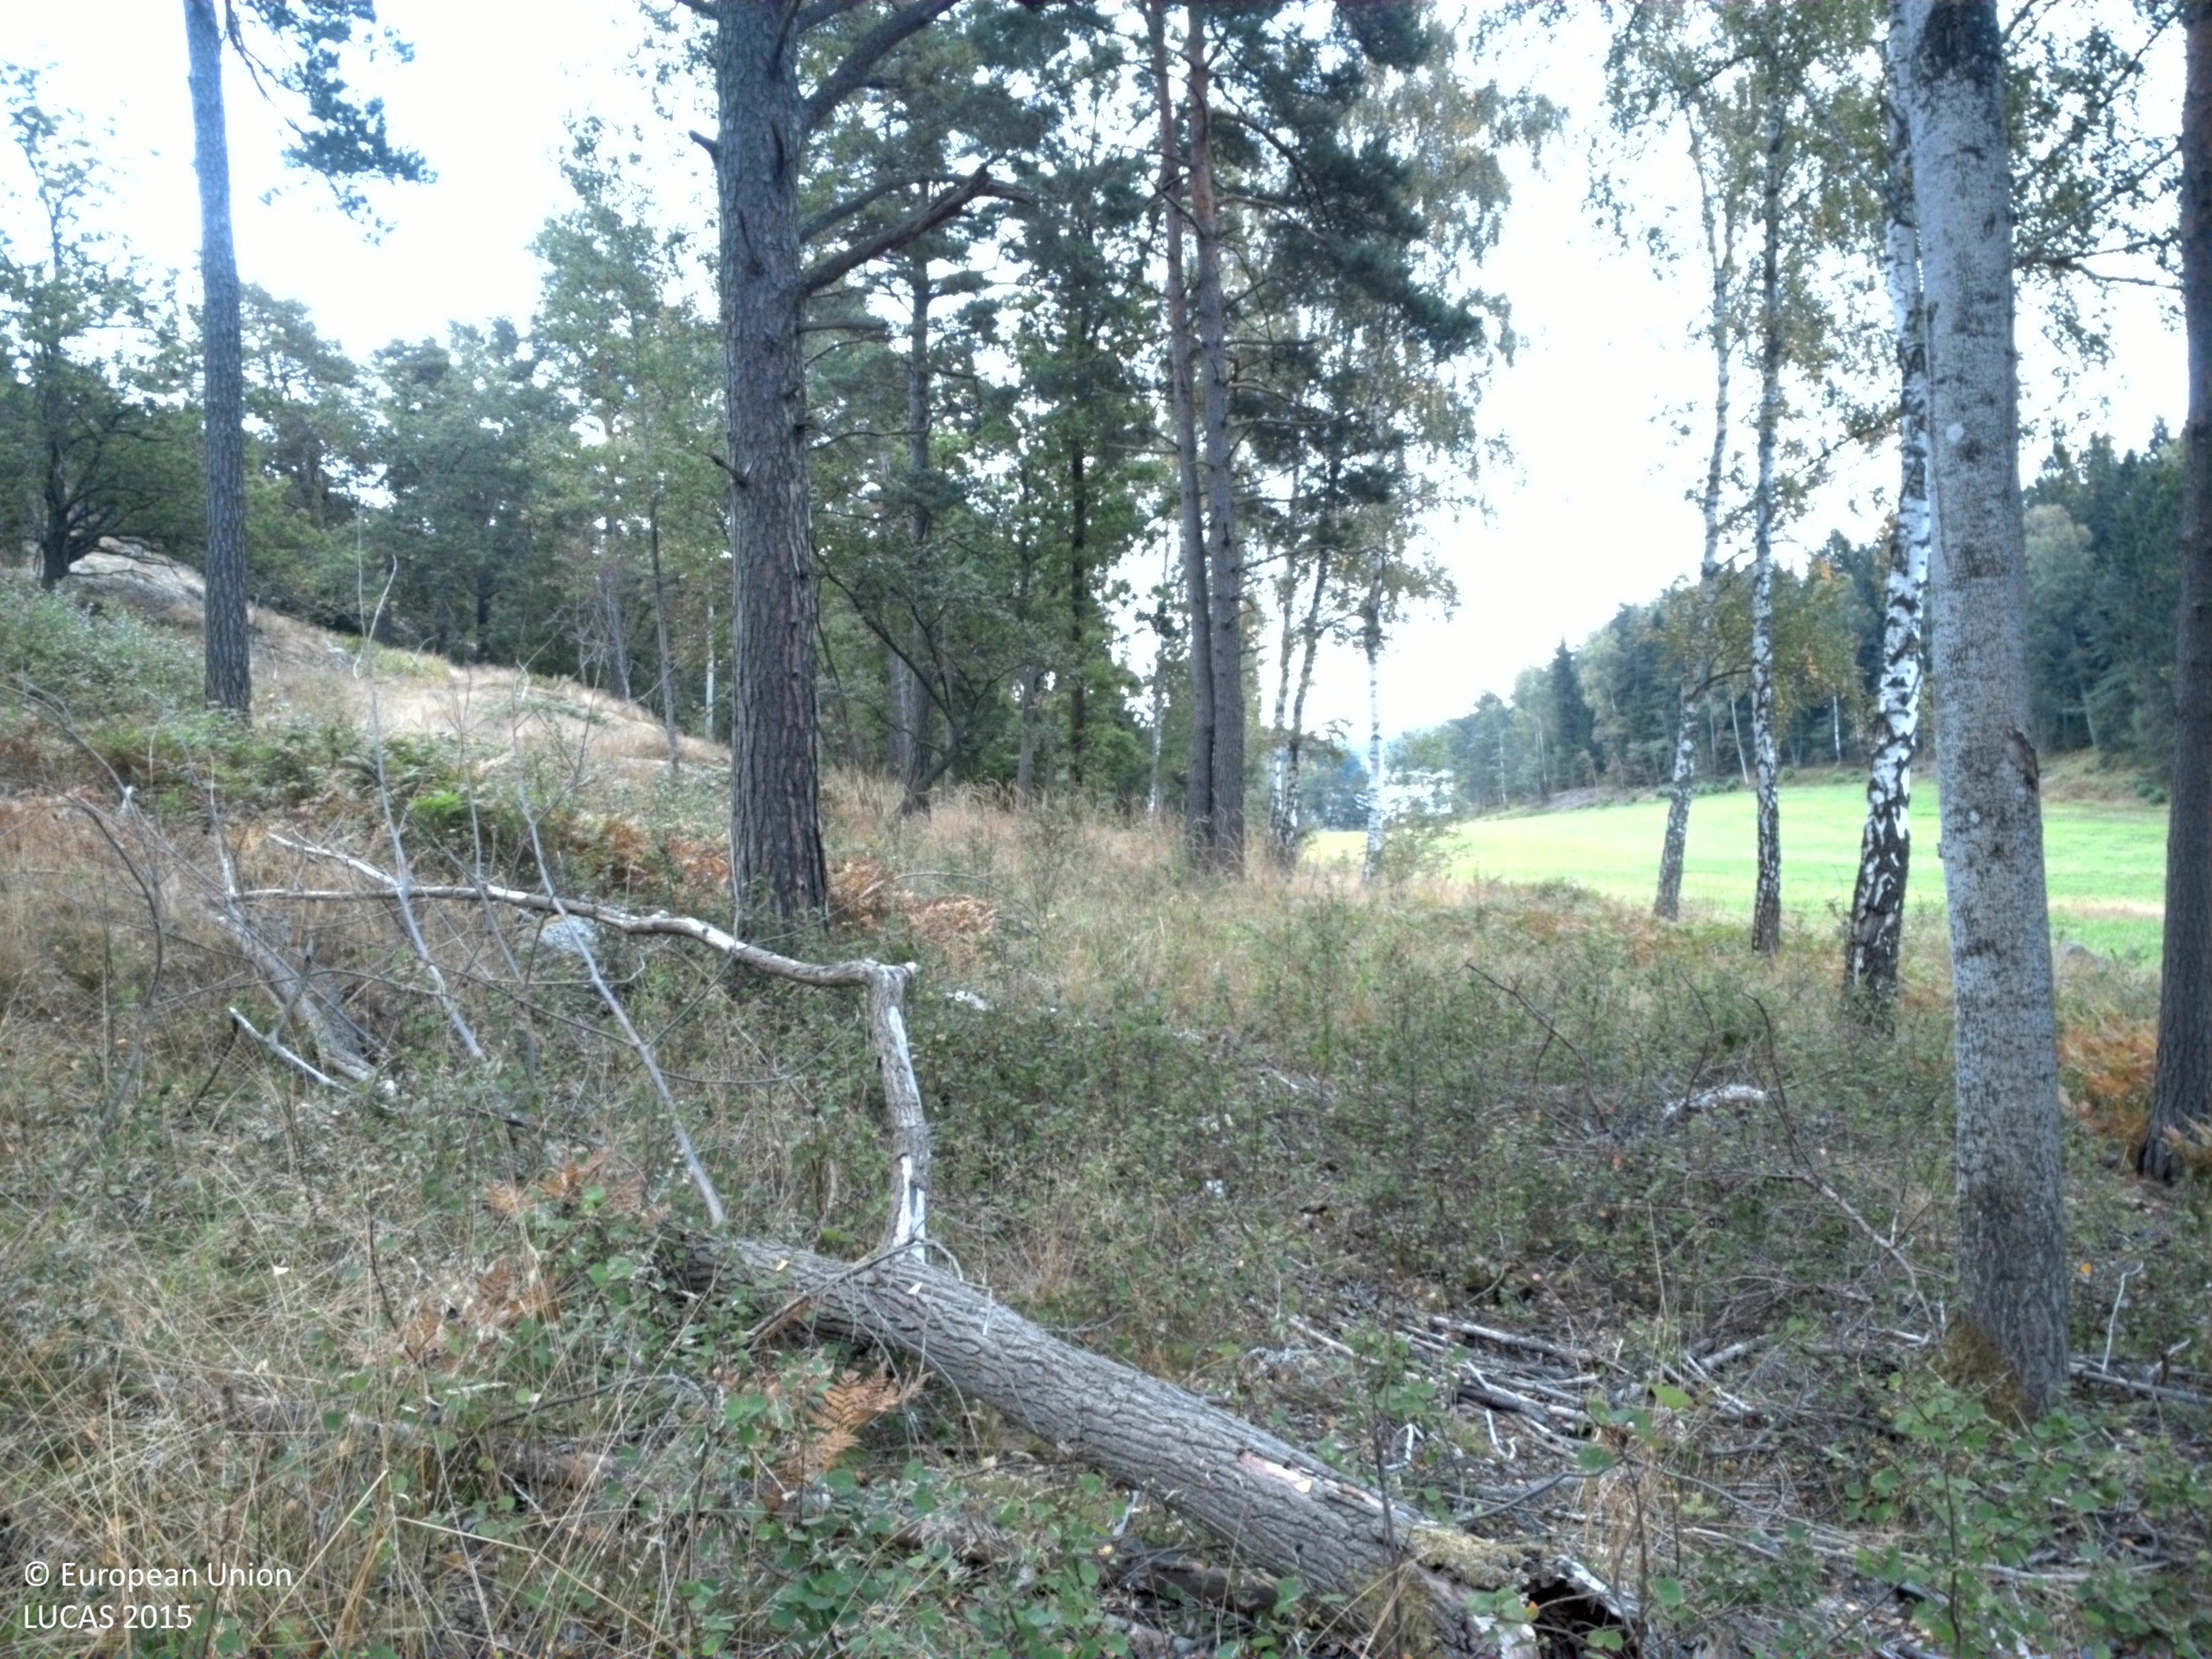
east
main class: Woodland
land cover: Broadleaved woodland
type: boreal forest
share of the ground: 50 - 75 %
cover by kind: broadleaved forest trees 50 %, herbaceous plants 40 %, coniferous forest trees 10 %
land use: Forestry
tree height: > 5 m
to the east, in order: Broadleaved woodland; Tracks; Grass margins; Ditches and canals; Other leguminous and mixtures for fodder
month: September
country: SE
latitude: 59.2953
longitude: 18.4109
